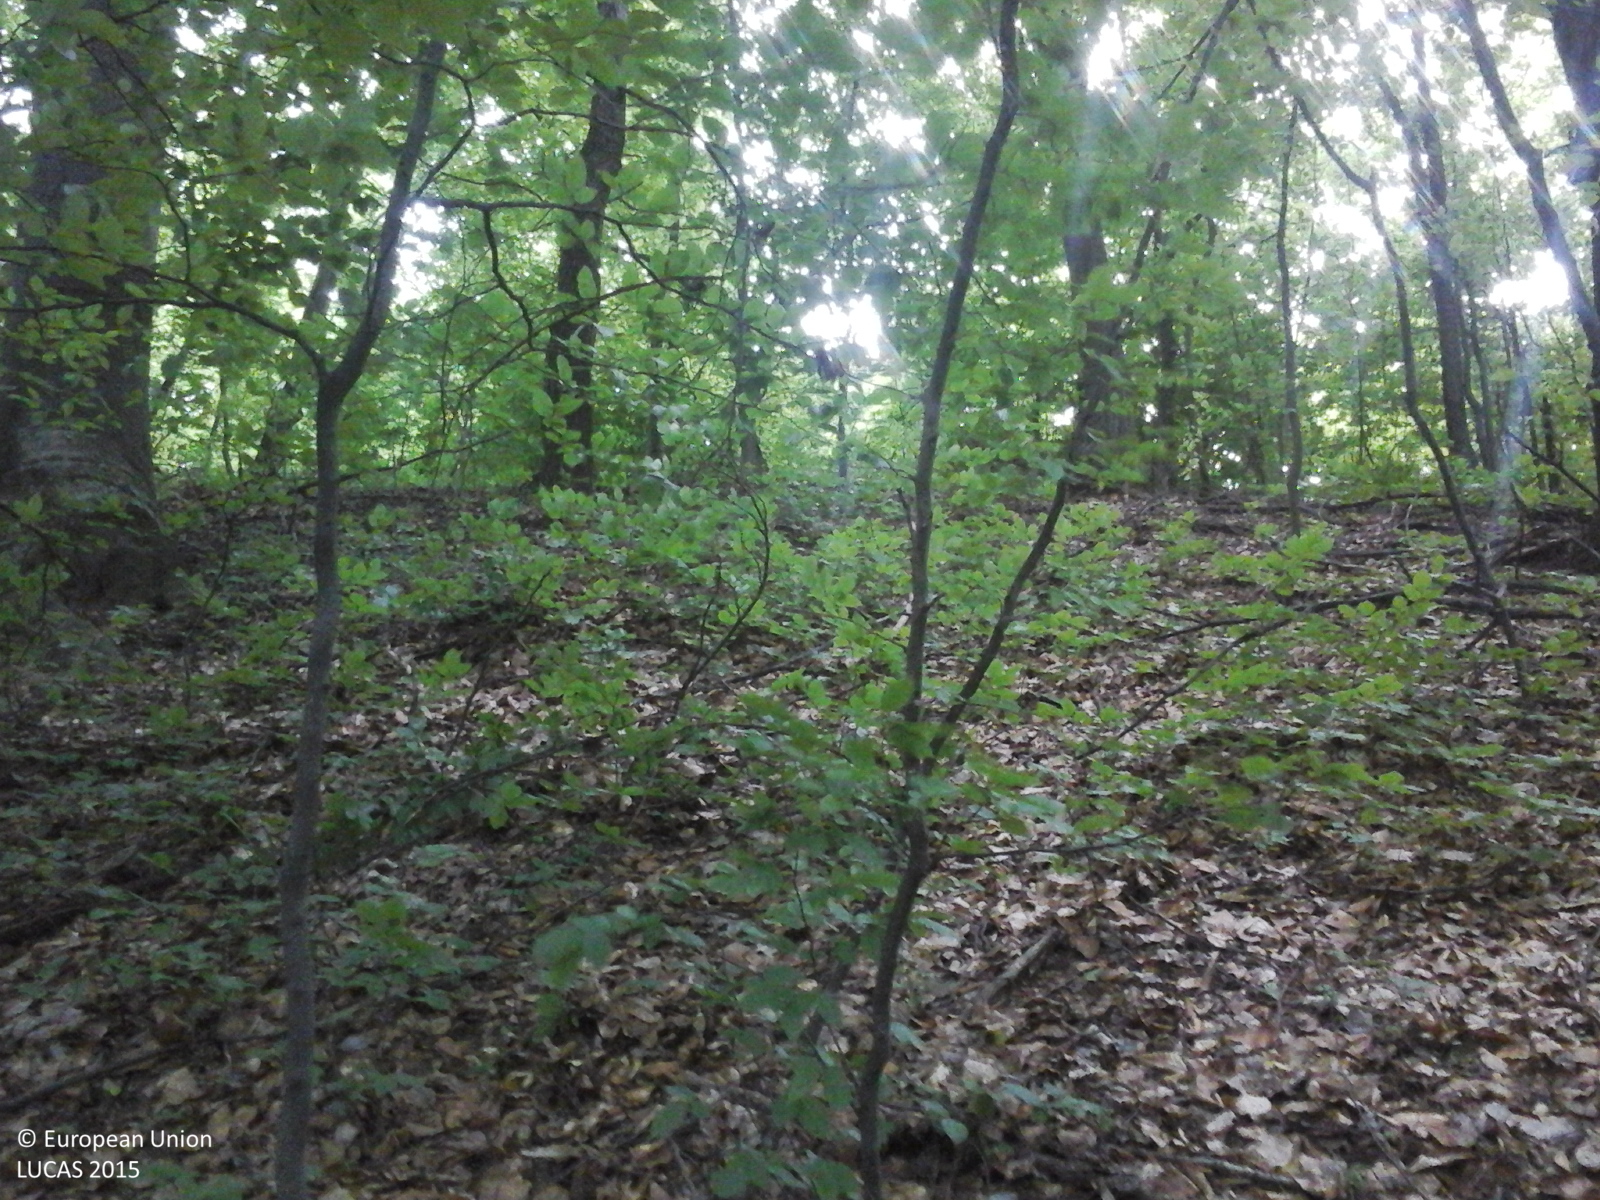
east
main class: Woodland
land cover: Broadleaved woodland
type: beech forest
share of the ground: > 75 %
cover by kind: broadleaved forest trees 100 %
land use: Forestry
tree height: > 5 m
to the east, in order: Broadleaved woodland; Grassland with sparse tree/shrub cover; Tracks; Grassland without tree/shrub cover; Broadleaved woodland
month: June
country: RO
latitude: 46.6161
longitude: 26.5236
